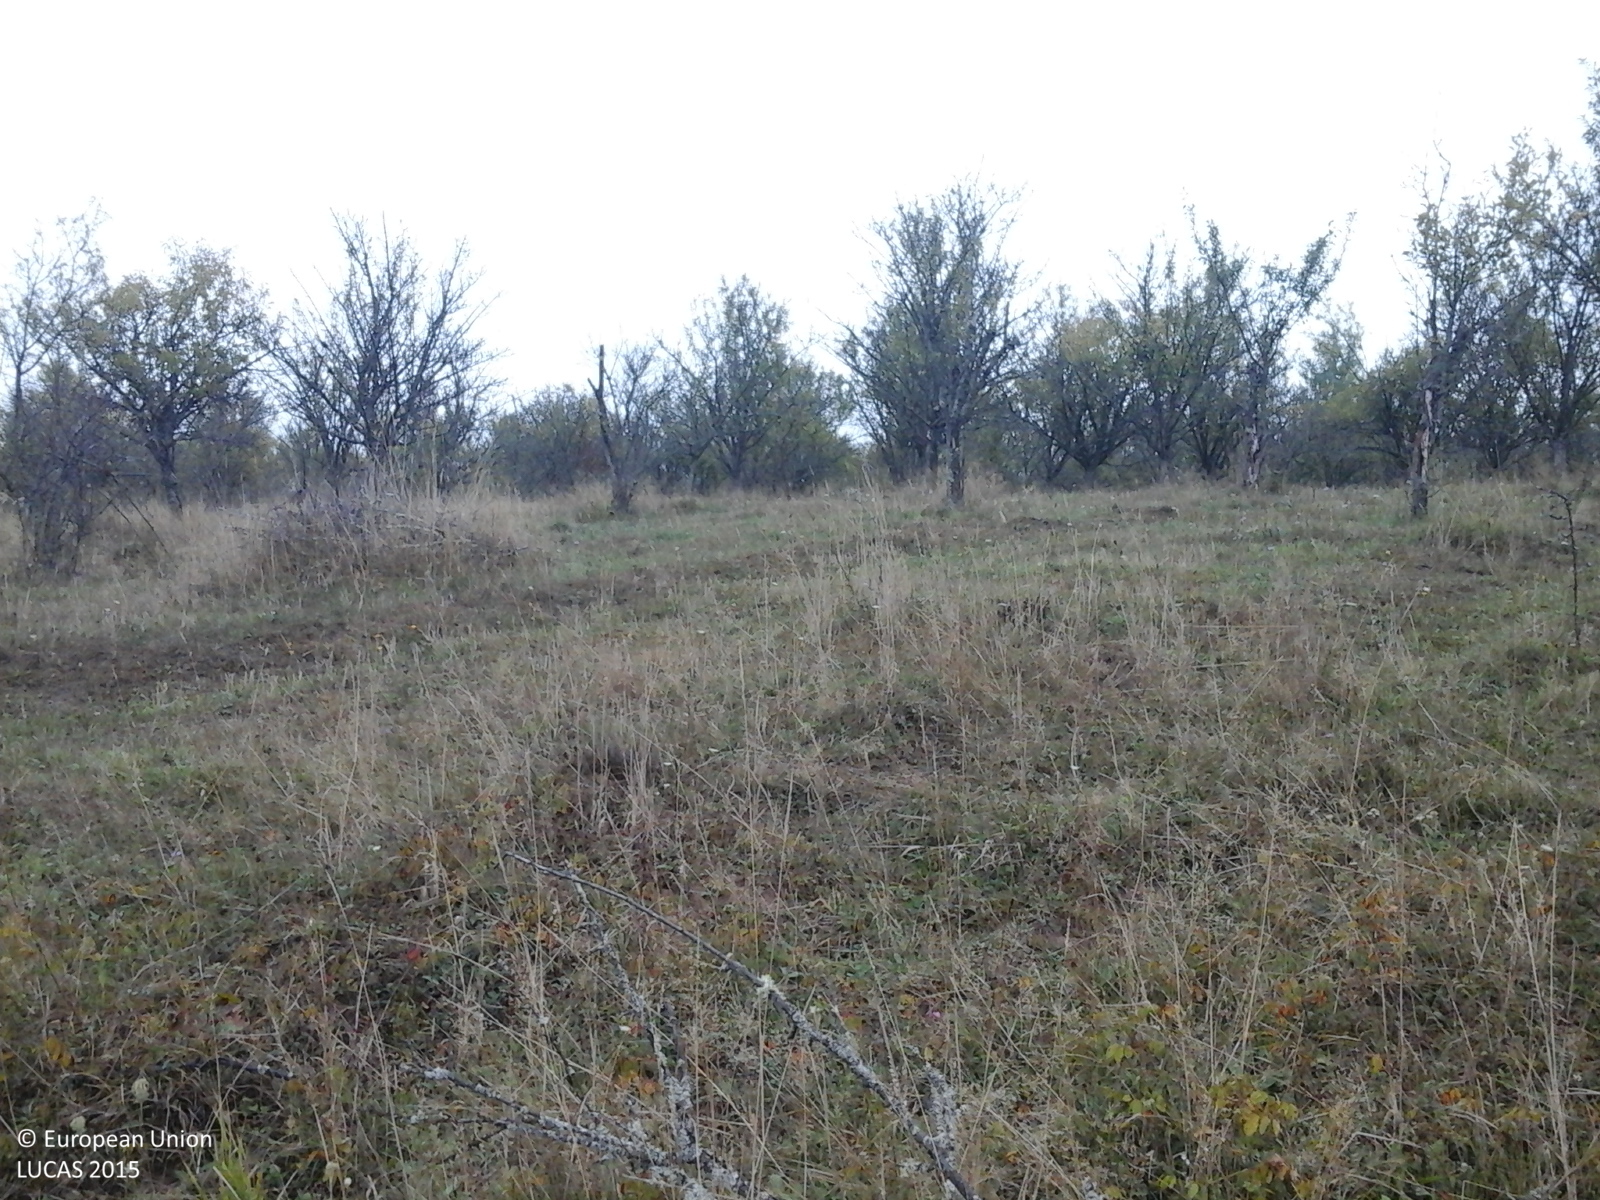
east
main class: Cropland
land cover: Apple fruit
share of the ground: > 75 %
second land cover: Grassland without tree/shrub cover
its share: > 75 %
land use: Agriculture (excluding fallow land and kitchen gardens)
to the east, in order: Apple fruit; Grassland without tree/shrub cover; Lines of trees; Grassland with sparse tree/shrub cover; Tracks; Grassland with sparse tree/shrub cover; Broadleaved woodland; Grassland with sparse tree/shrub cover
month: September
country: RO
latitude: 45.5261
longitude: 22.0101
